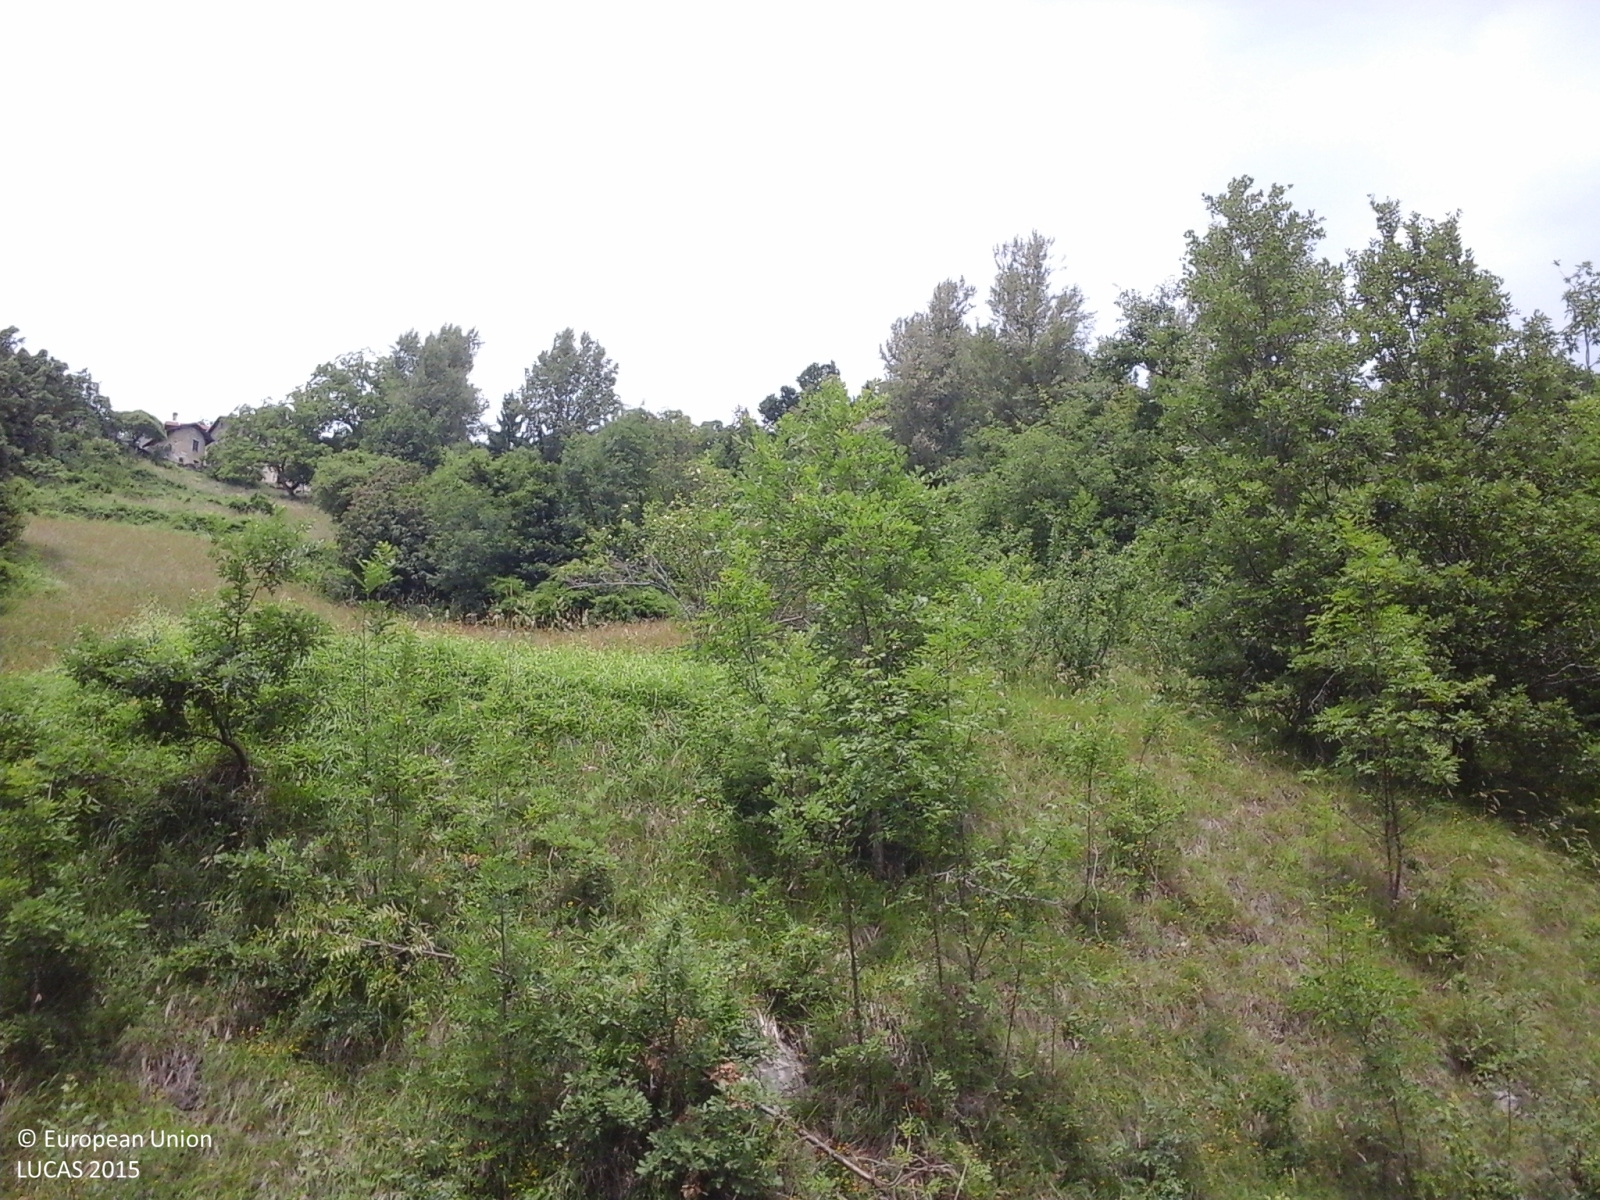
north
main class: Woodland
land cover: Broadleaved woodland
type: thermophilous deciduous forest
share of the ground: > 75 %
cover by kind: broadleaved forest trees 80 %, shrubs 20 %
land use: Forestry
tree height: > 5 m
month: June
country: IT
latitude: 44.6023
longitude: 9.6103
